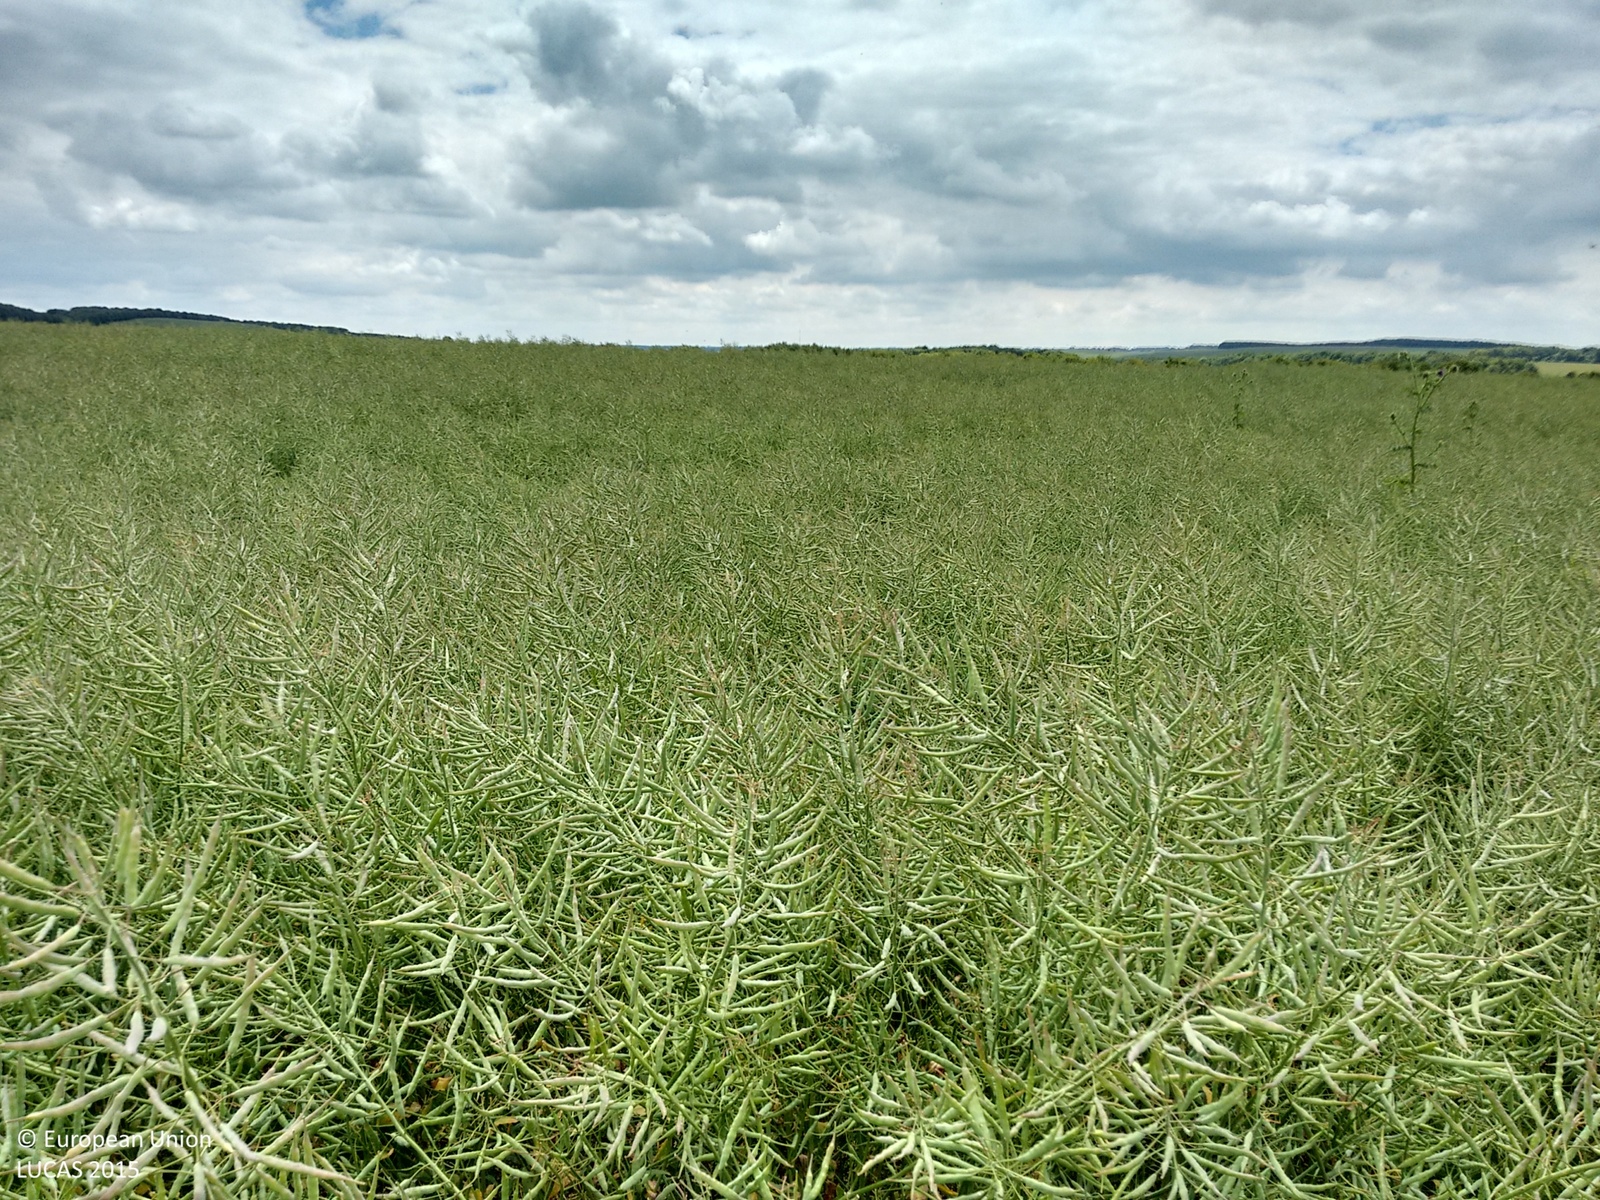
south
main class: Cropland
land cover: Rape and turnip rape
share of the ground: > 75 %
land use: Agriculture (excluding fallow land and kitchen gardens)
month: June
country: GB
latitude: 51.5723
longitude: -1.5806
